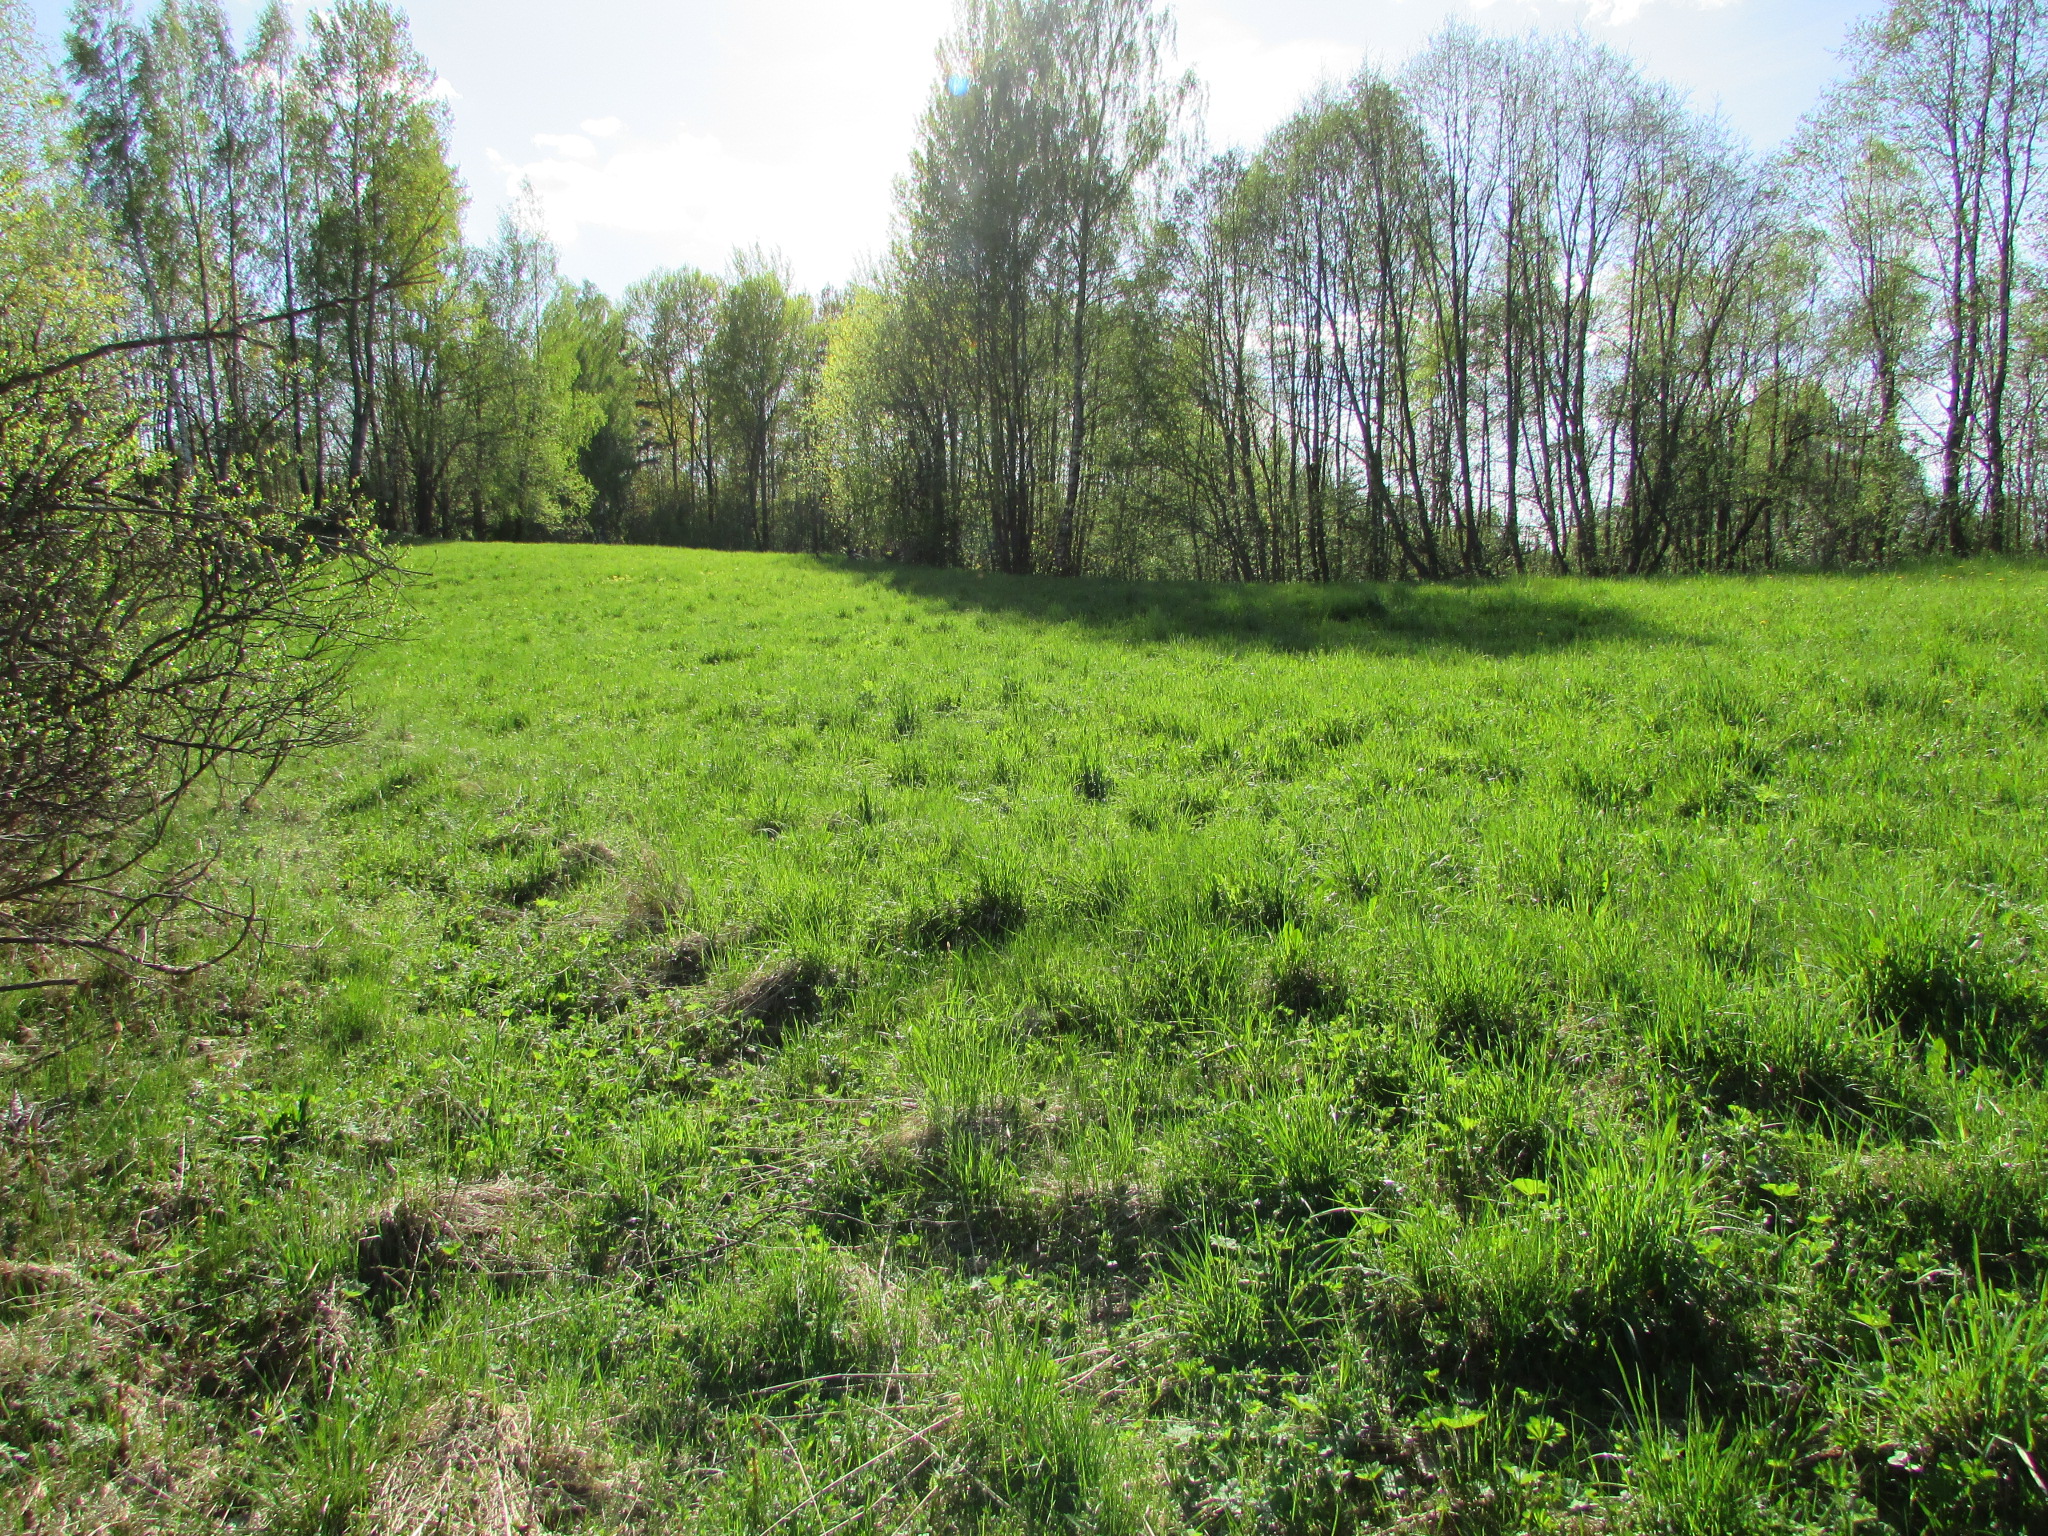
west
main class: Woodland
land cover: Broadleaved woodland
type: non-riverine alder, birch or aspen forest
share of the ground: > 75 %
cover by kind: broadleaved forest trees 100 %
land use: Semi-natural and natural areas not in use
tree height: > 5 m
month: May
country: LV
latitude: 56.1270
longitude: 27.1418
